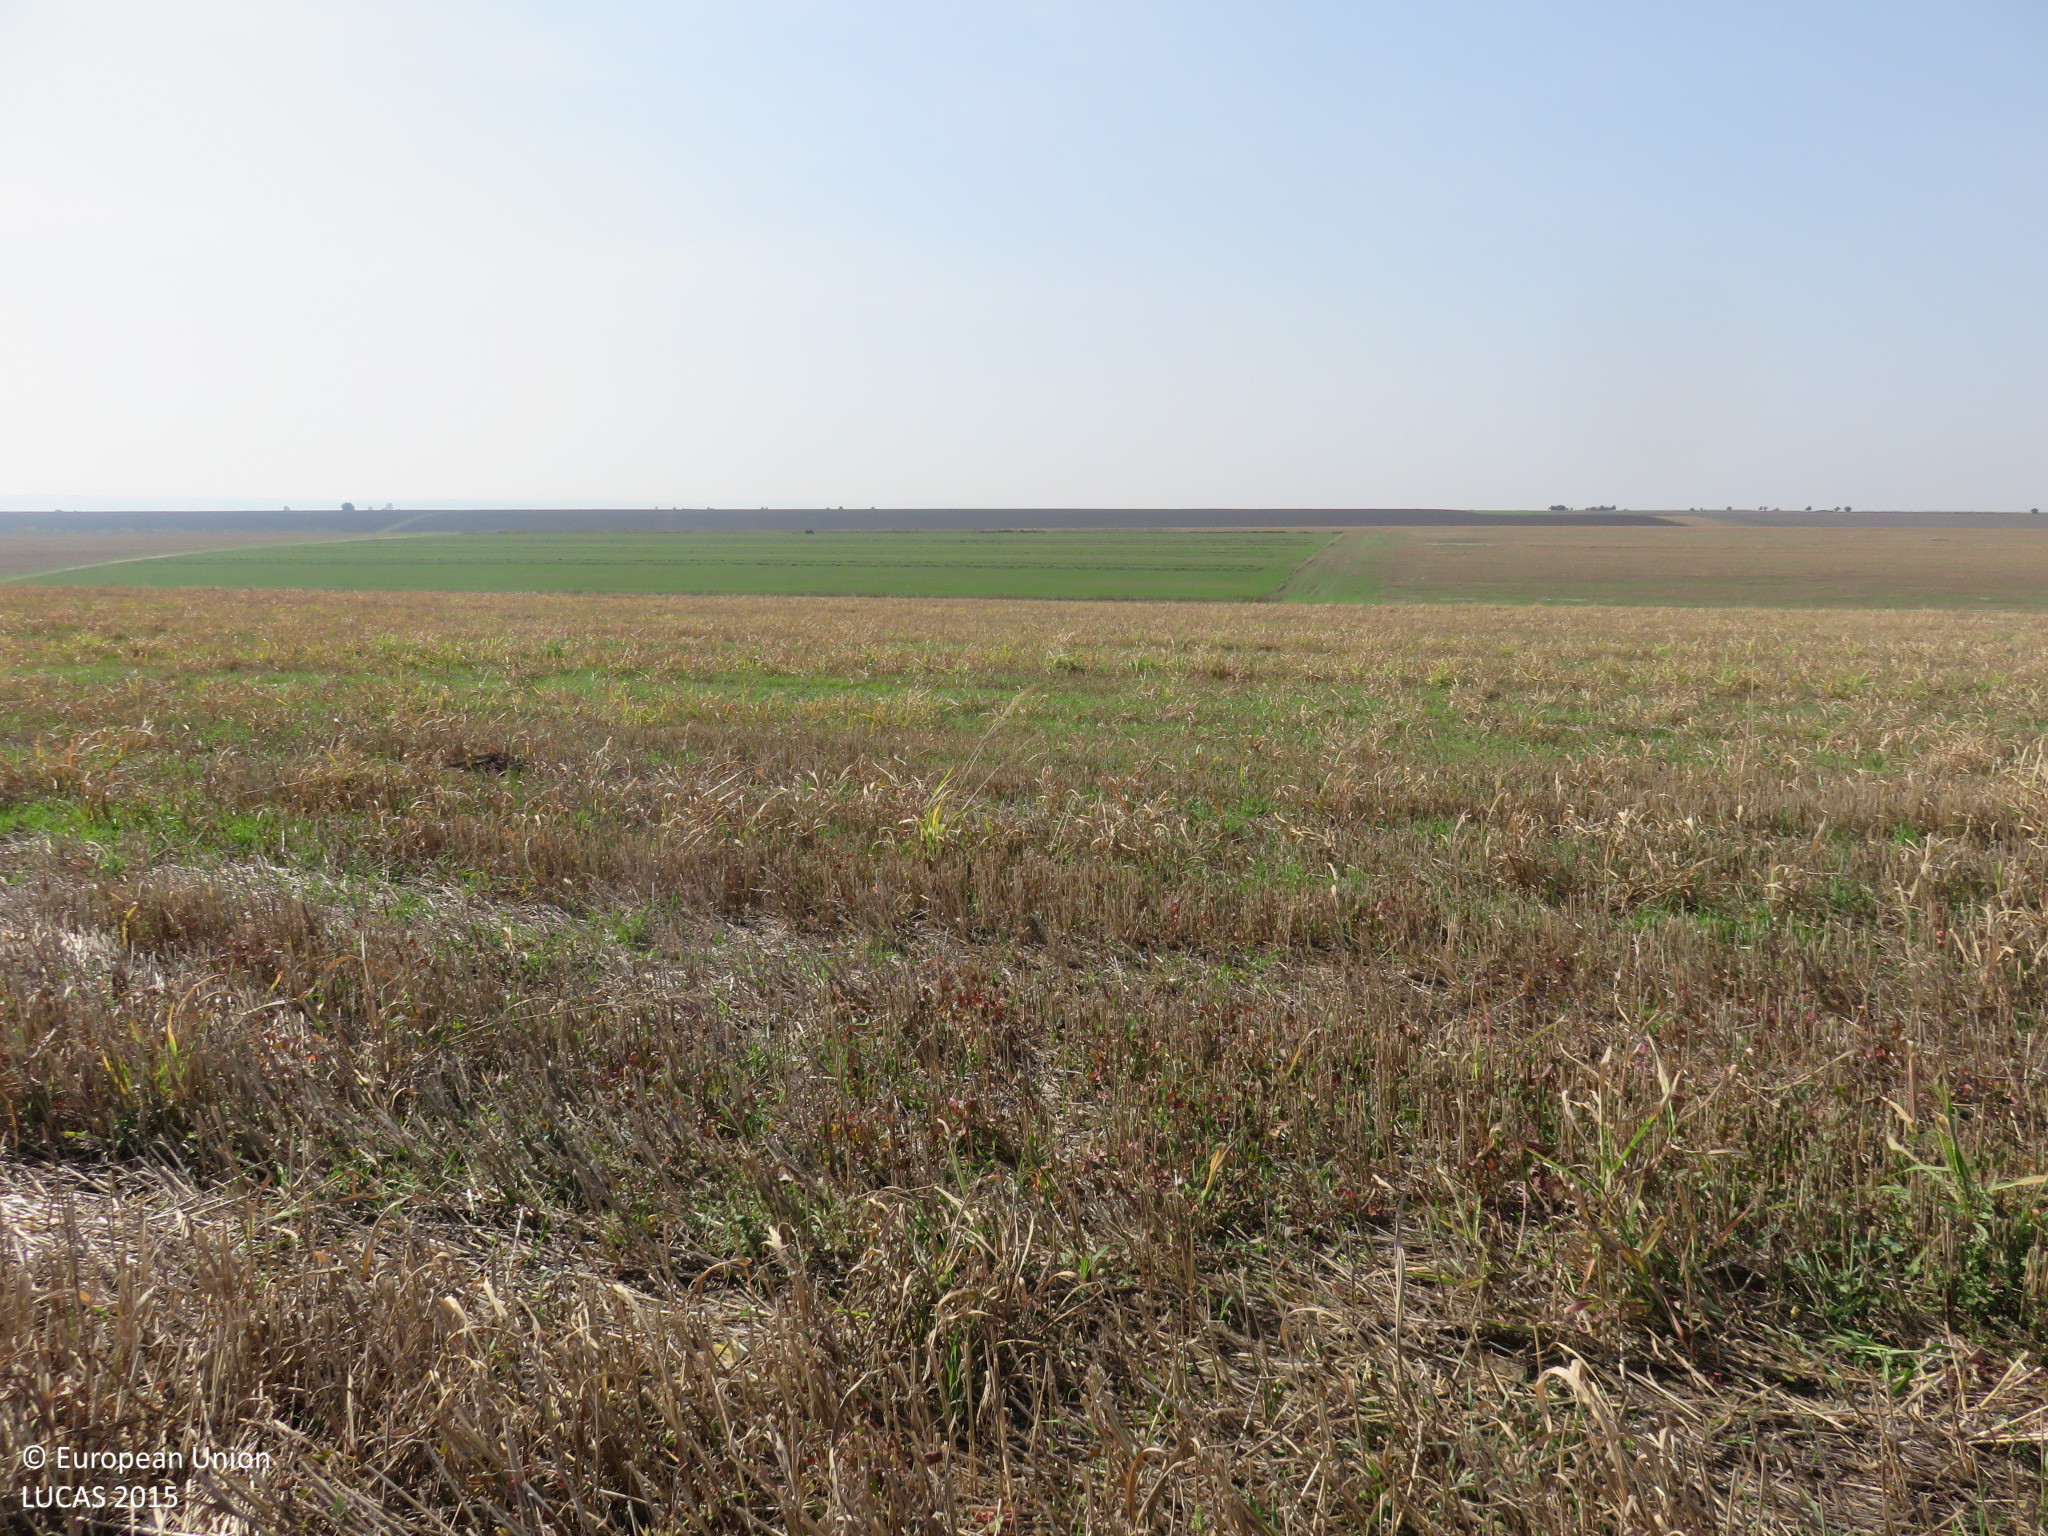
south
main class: Cropland
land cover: Common wheat
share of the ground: > 75 %
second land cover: Spontaneously vegetated surfaces
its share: < 10 %
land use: Agriculture (excluding fallow land and kitchen gardens)
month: September
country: BG
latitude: 43.5941
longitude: 24.5435
